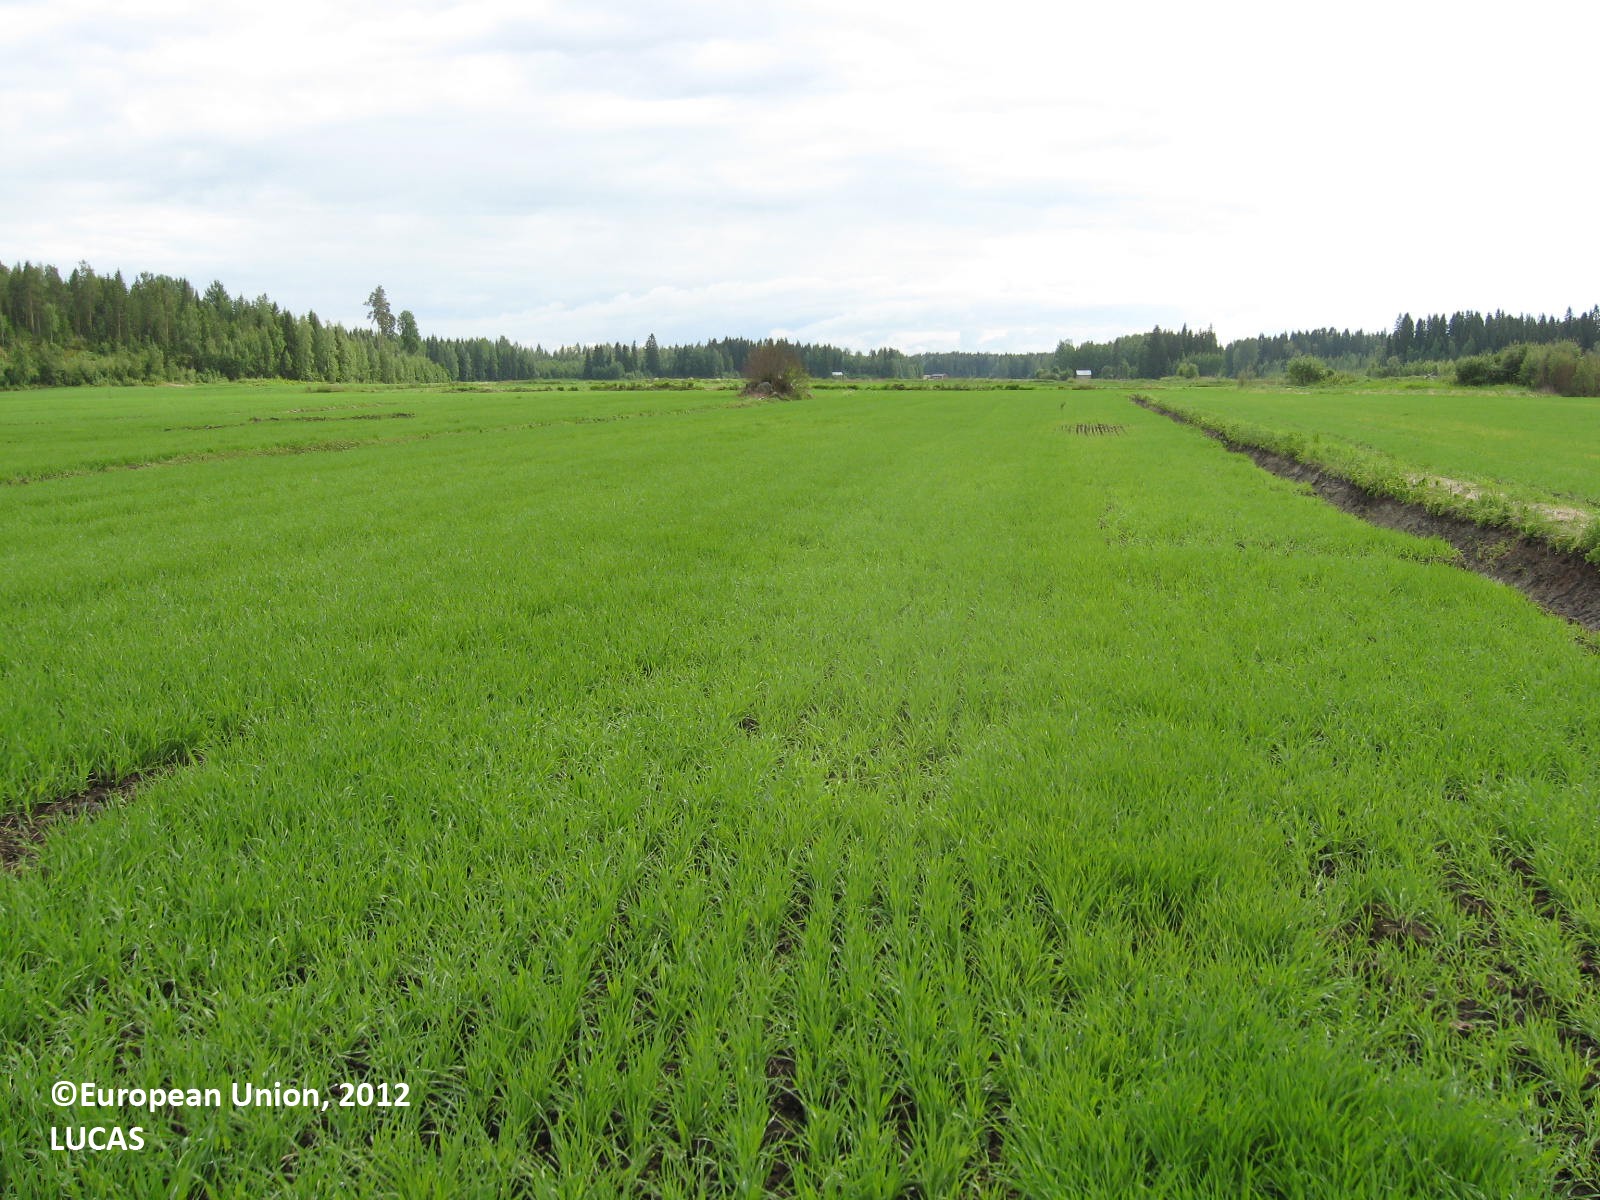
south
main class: Cropland
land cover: Barley
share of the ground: > 75 %
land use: Agriculture (excluding fallow land and kitchen gardens)
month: June
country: FI
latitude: 62.9918
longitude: 22.8668
